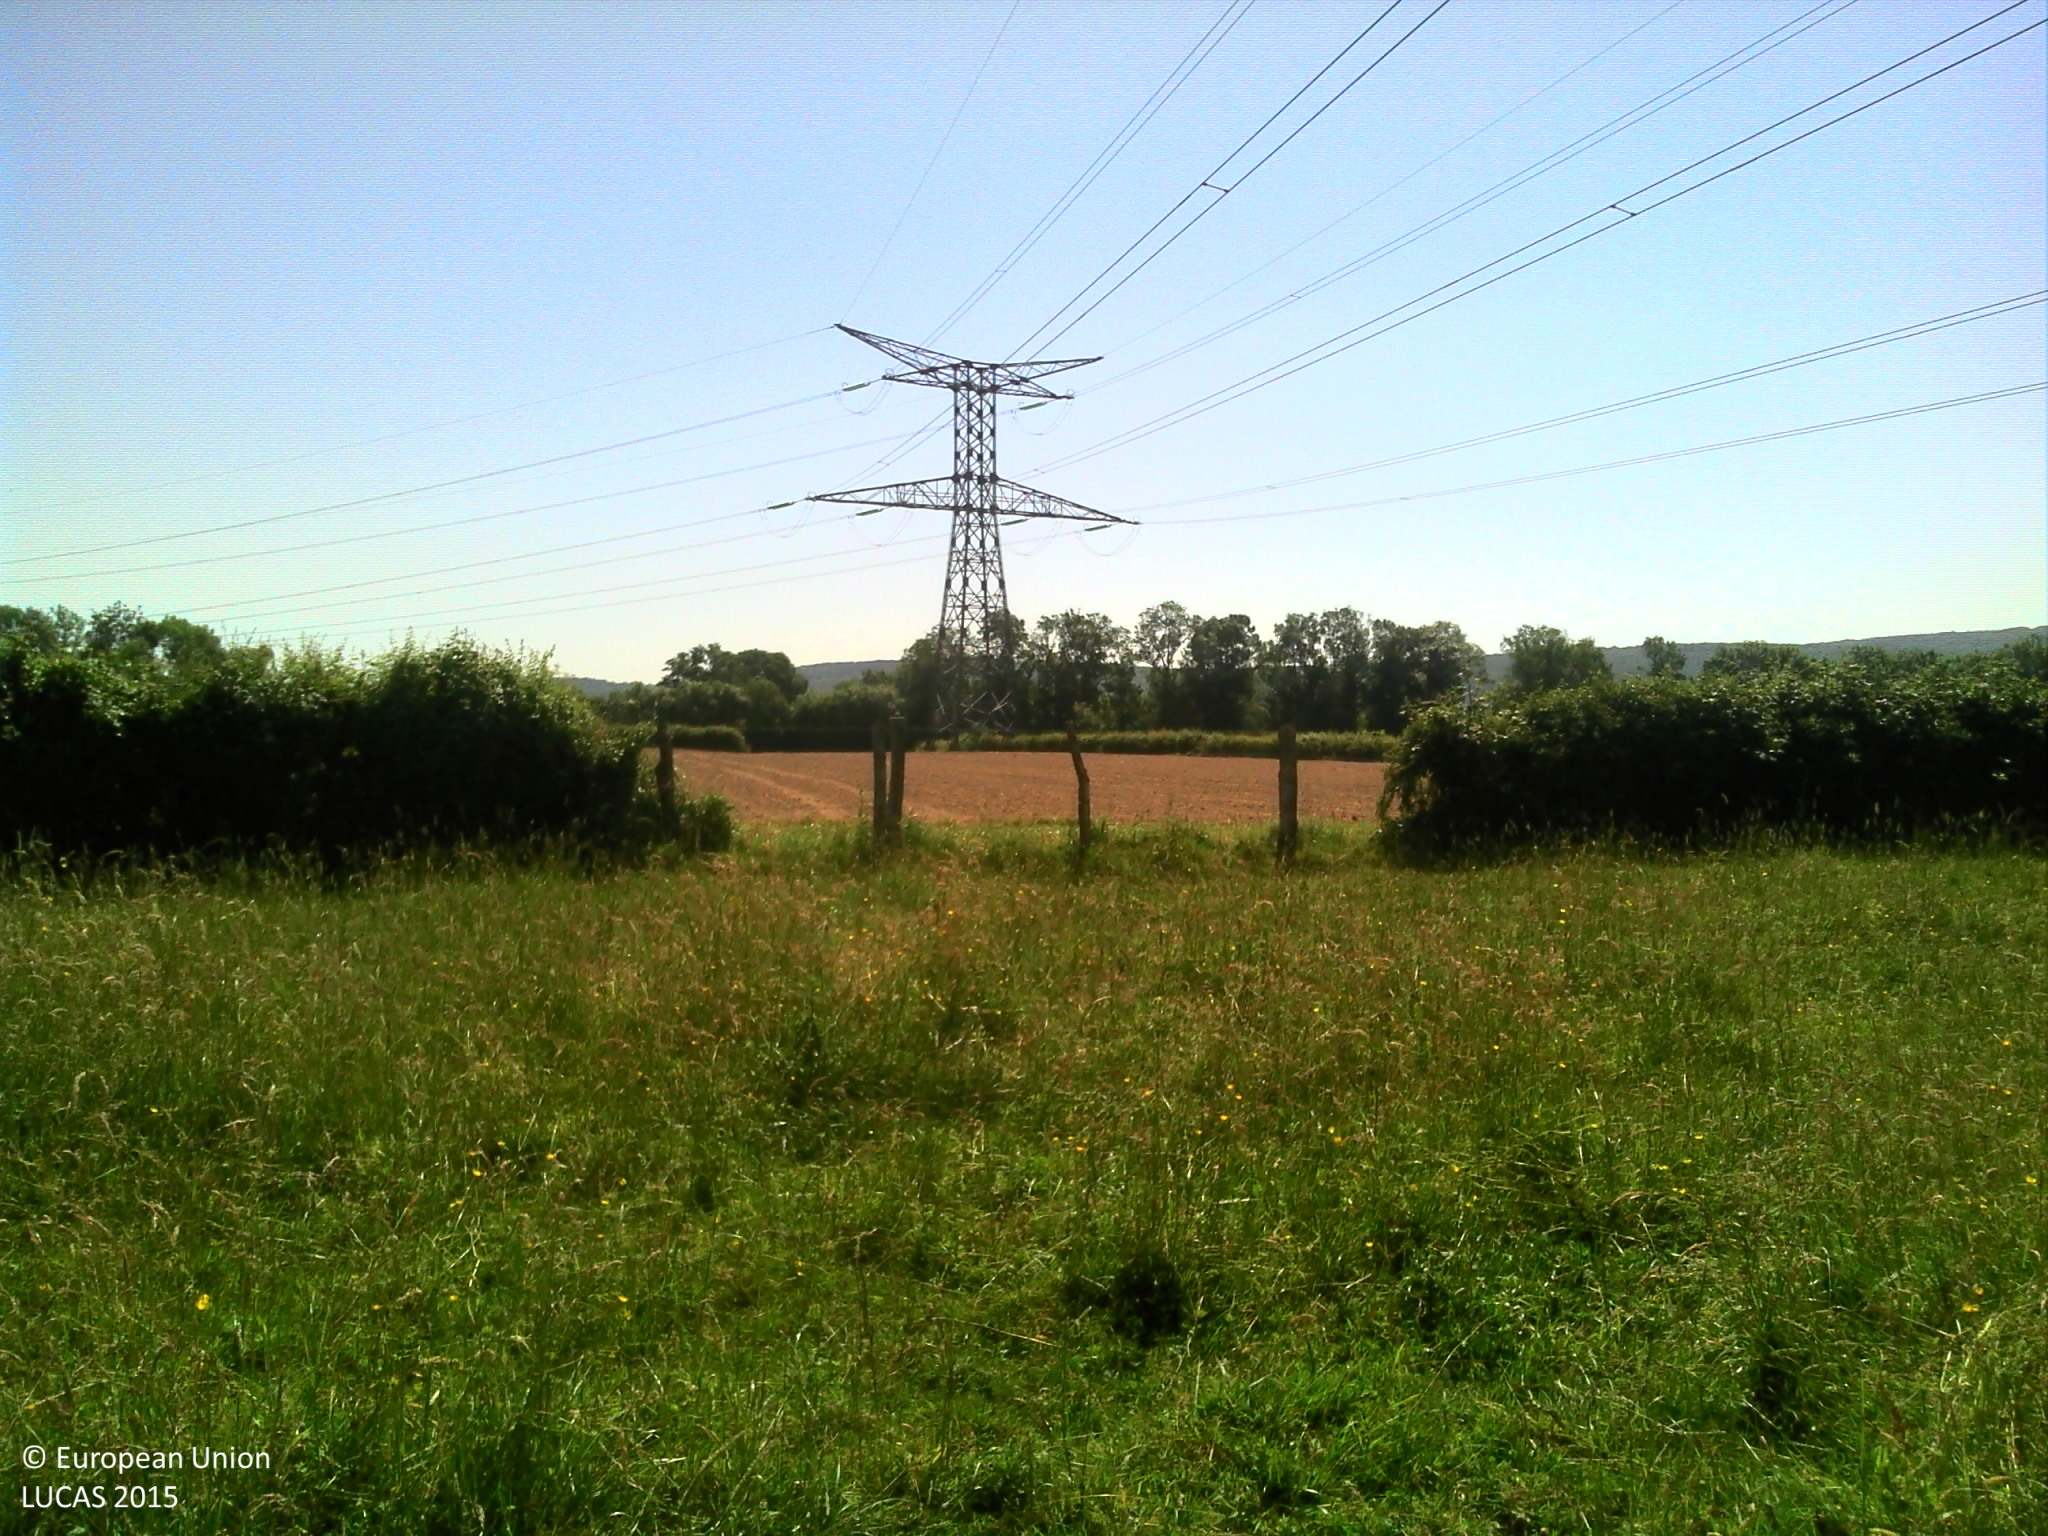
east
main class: Grassland
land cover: Grassland without tree/shrub cover
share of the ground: > 75 %
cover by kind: herbaceous plants 100 %
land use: Agriculture (excluding fallow land and kitchen gardens)
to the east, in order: Grassland without tree/shrub cover; Managed hedges; Fences; Grass margins; Other bare soil; Managed hedges; Grassland without tree/shrub cover; Electric lines; Shruby margins; Tracks; Broadleaved woodland; Grassland without tree/shrub cover
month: June
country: FR
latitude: 46.6393
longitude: 4.7891
